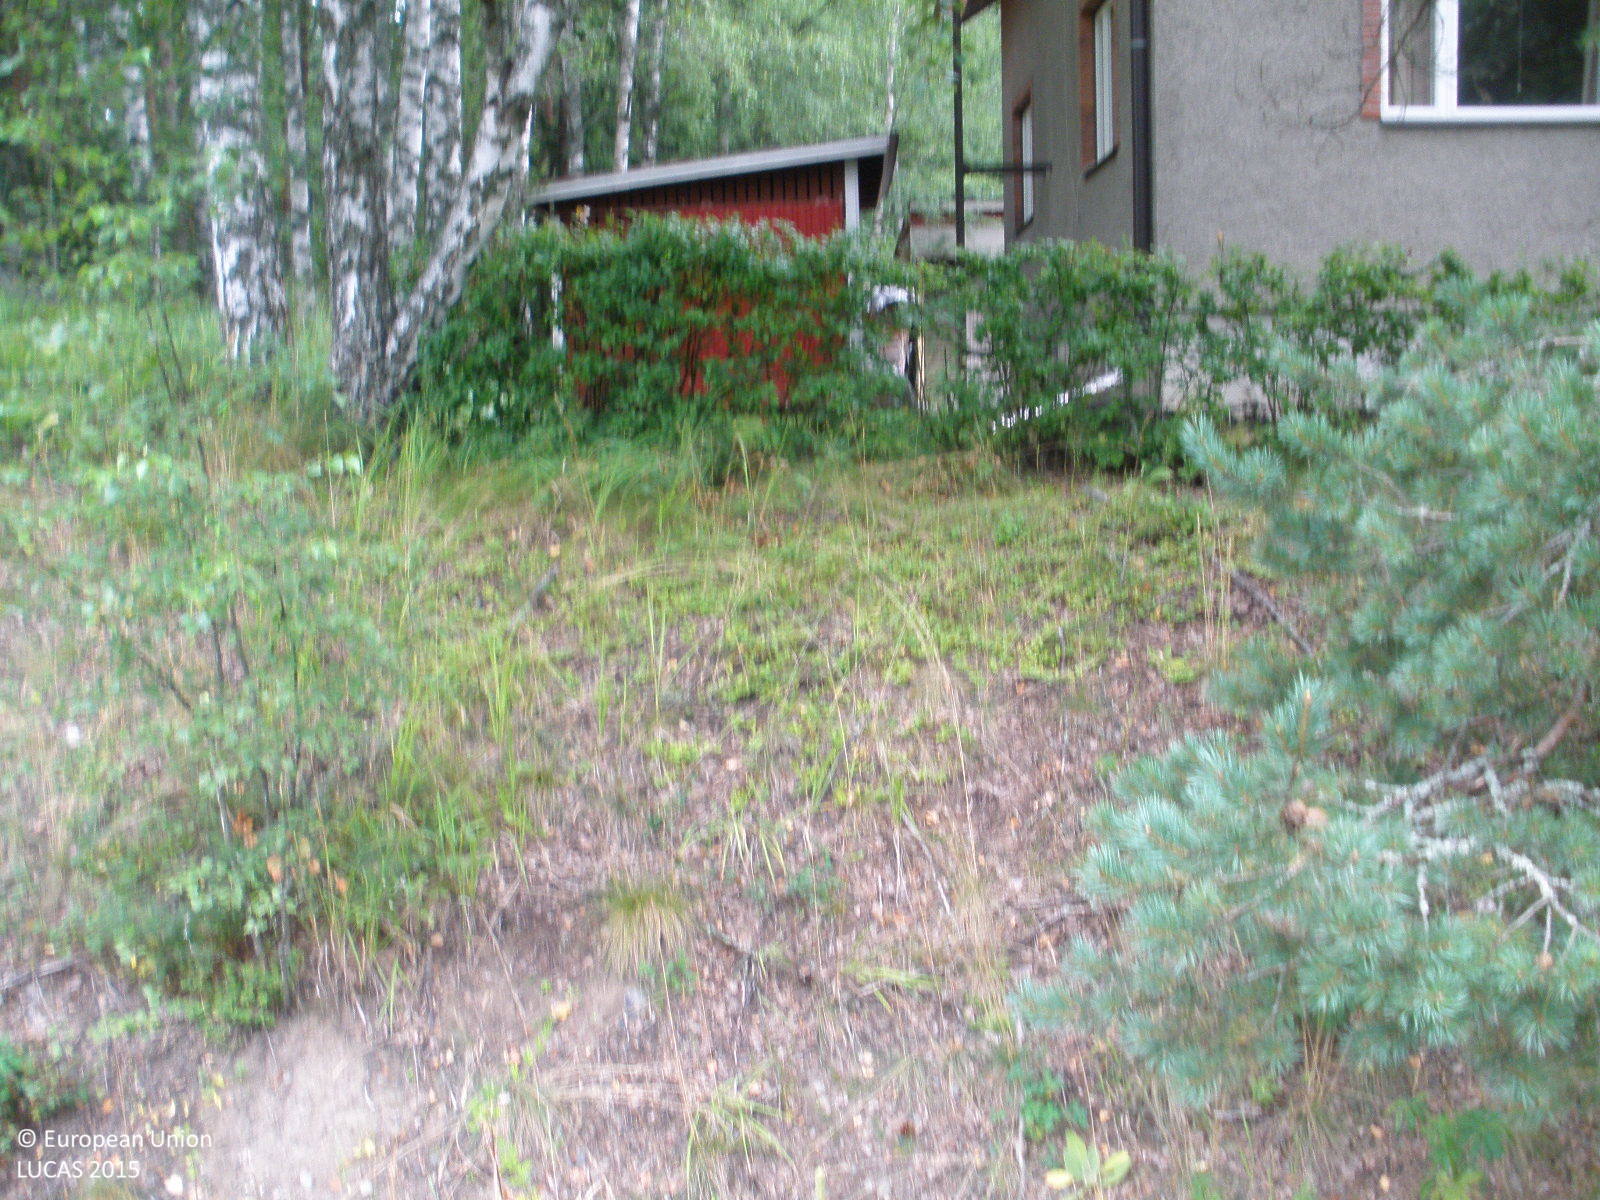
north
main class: Grassland
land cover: Grassland without tree/shrub cover
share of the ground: > 75 %
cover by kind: herbaceous plants 100 %
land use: Residential
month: August
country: FI
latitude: 60.9612
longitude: 24.5649
